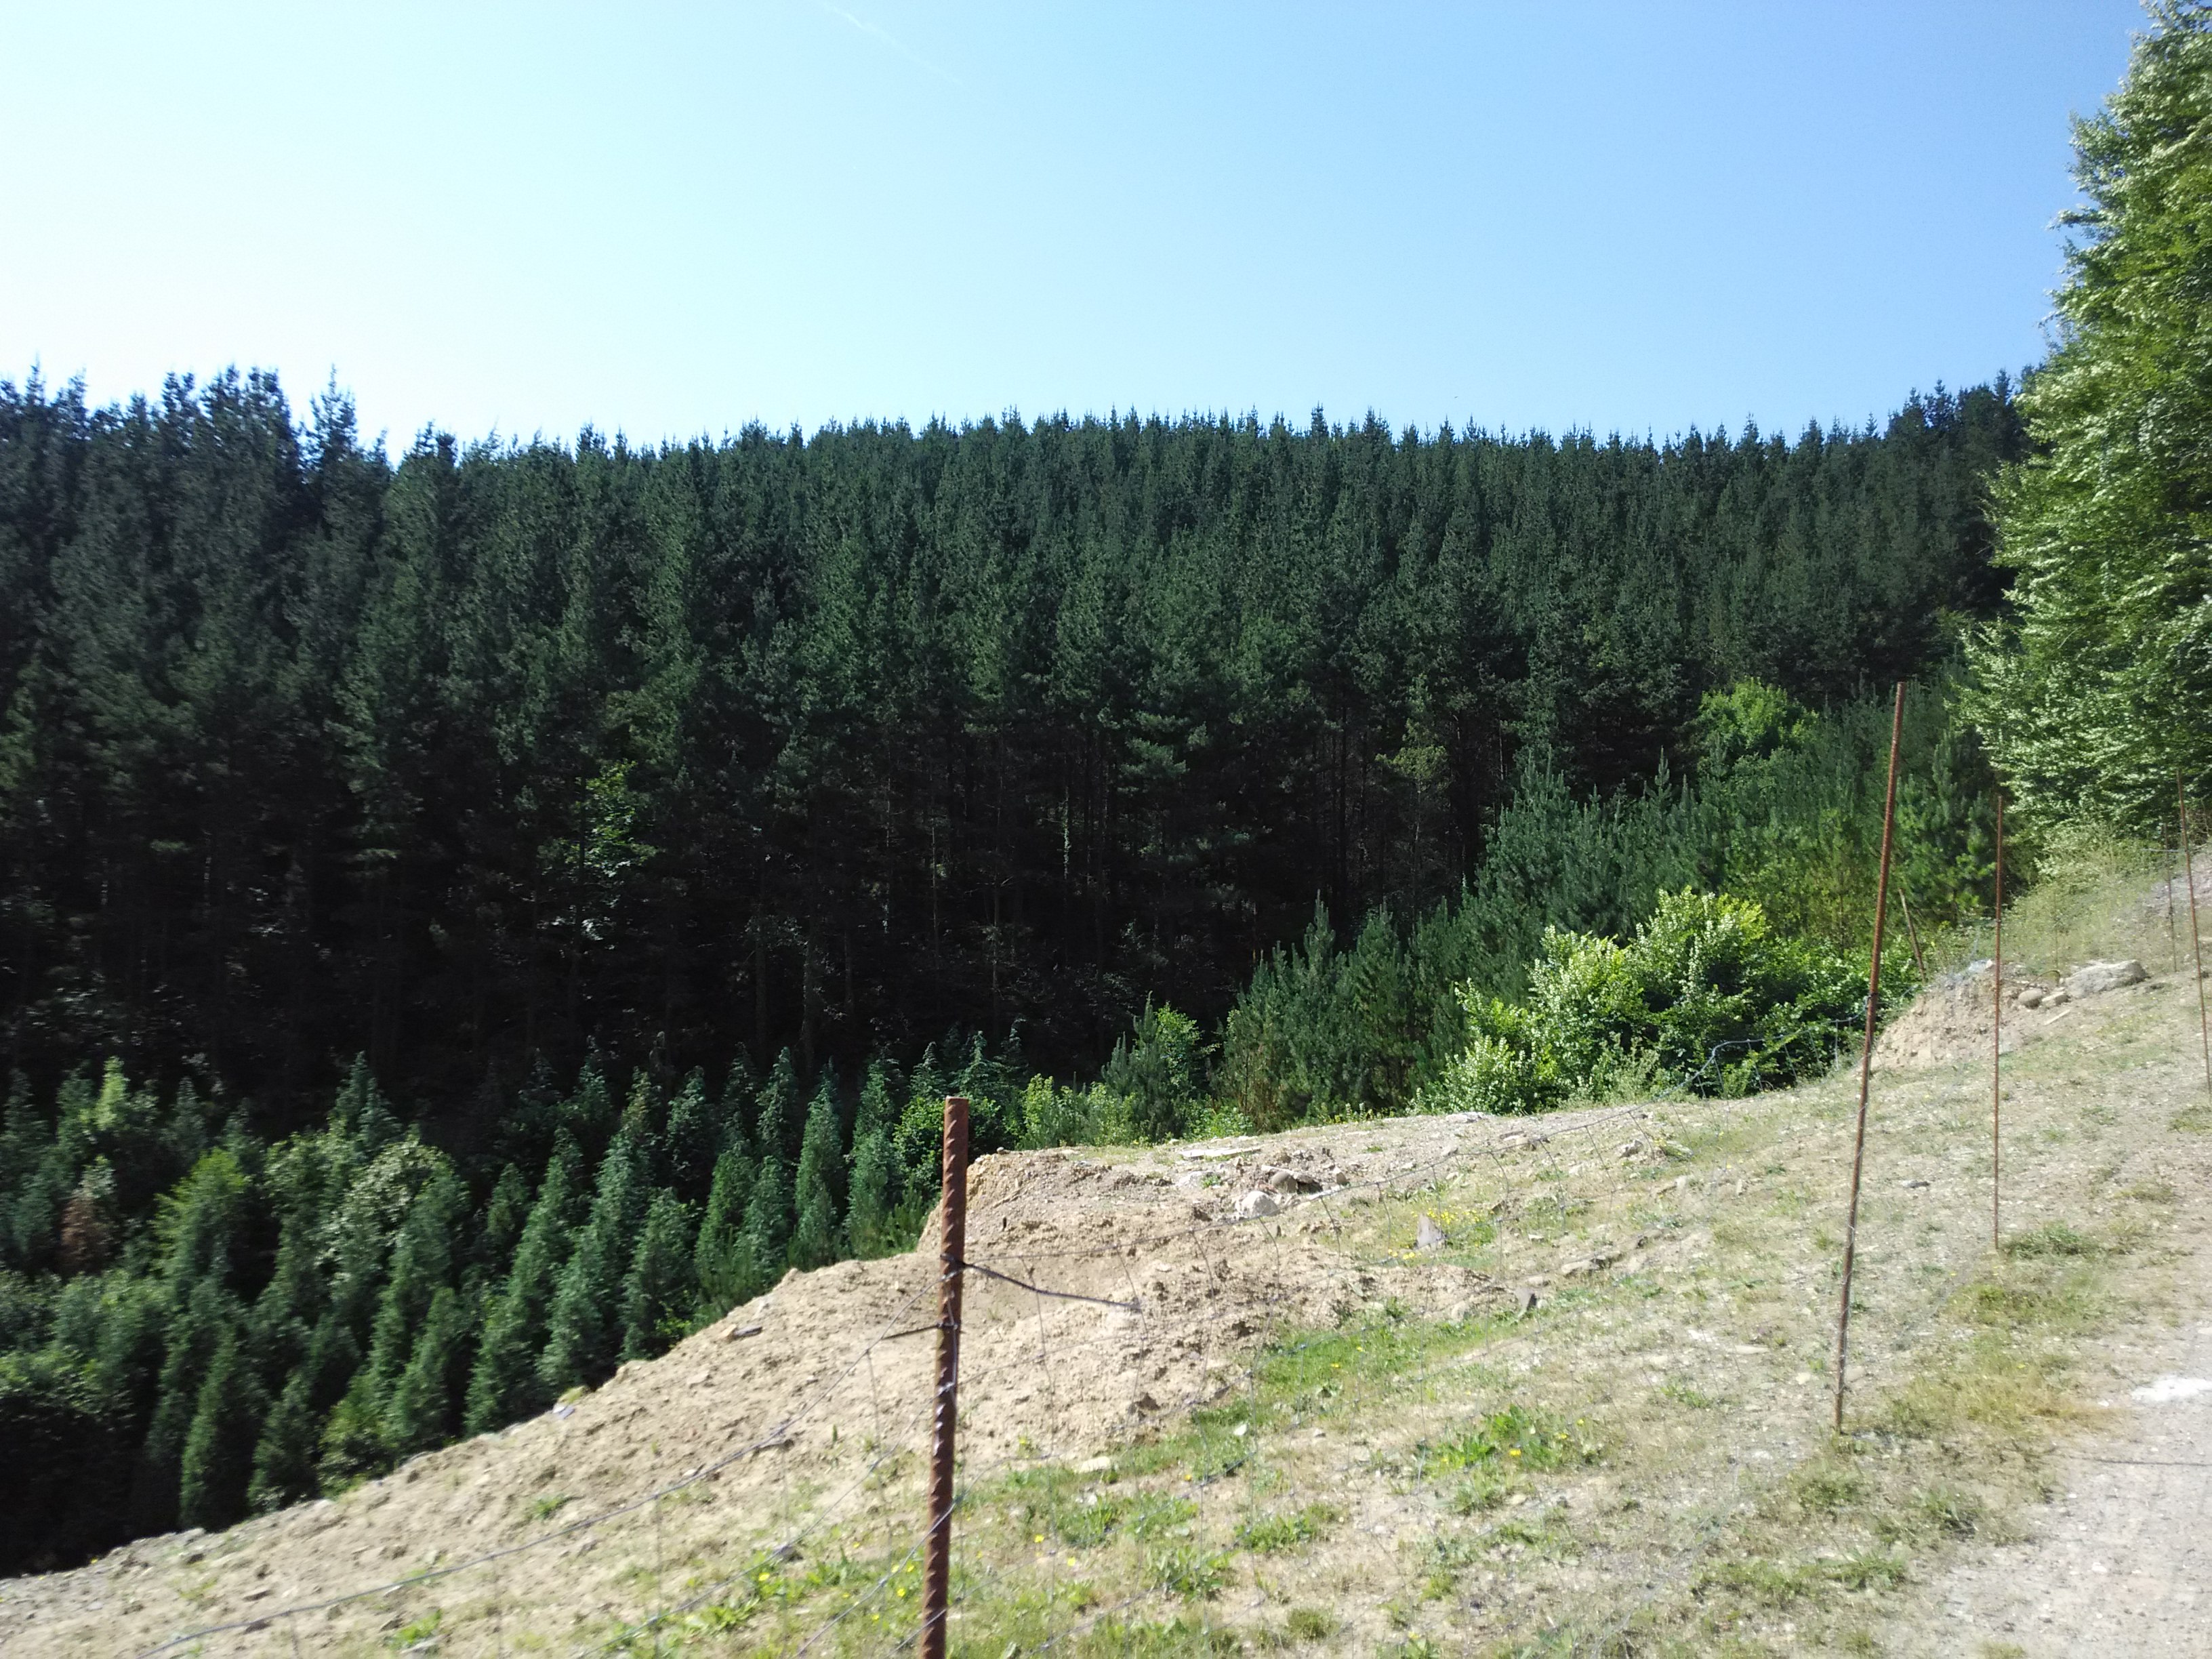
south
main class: Grassland
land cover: Grassland without tree/shrub cover
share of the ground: > 75 %
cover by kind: herbaceous plants 90 %, unconsolidated bare surface 10 %
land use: Agriculture (excluding fallow land and kitchen gardens)
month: July
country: ES
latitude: 43.1645
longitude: -2.2626
